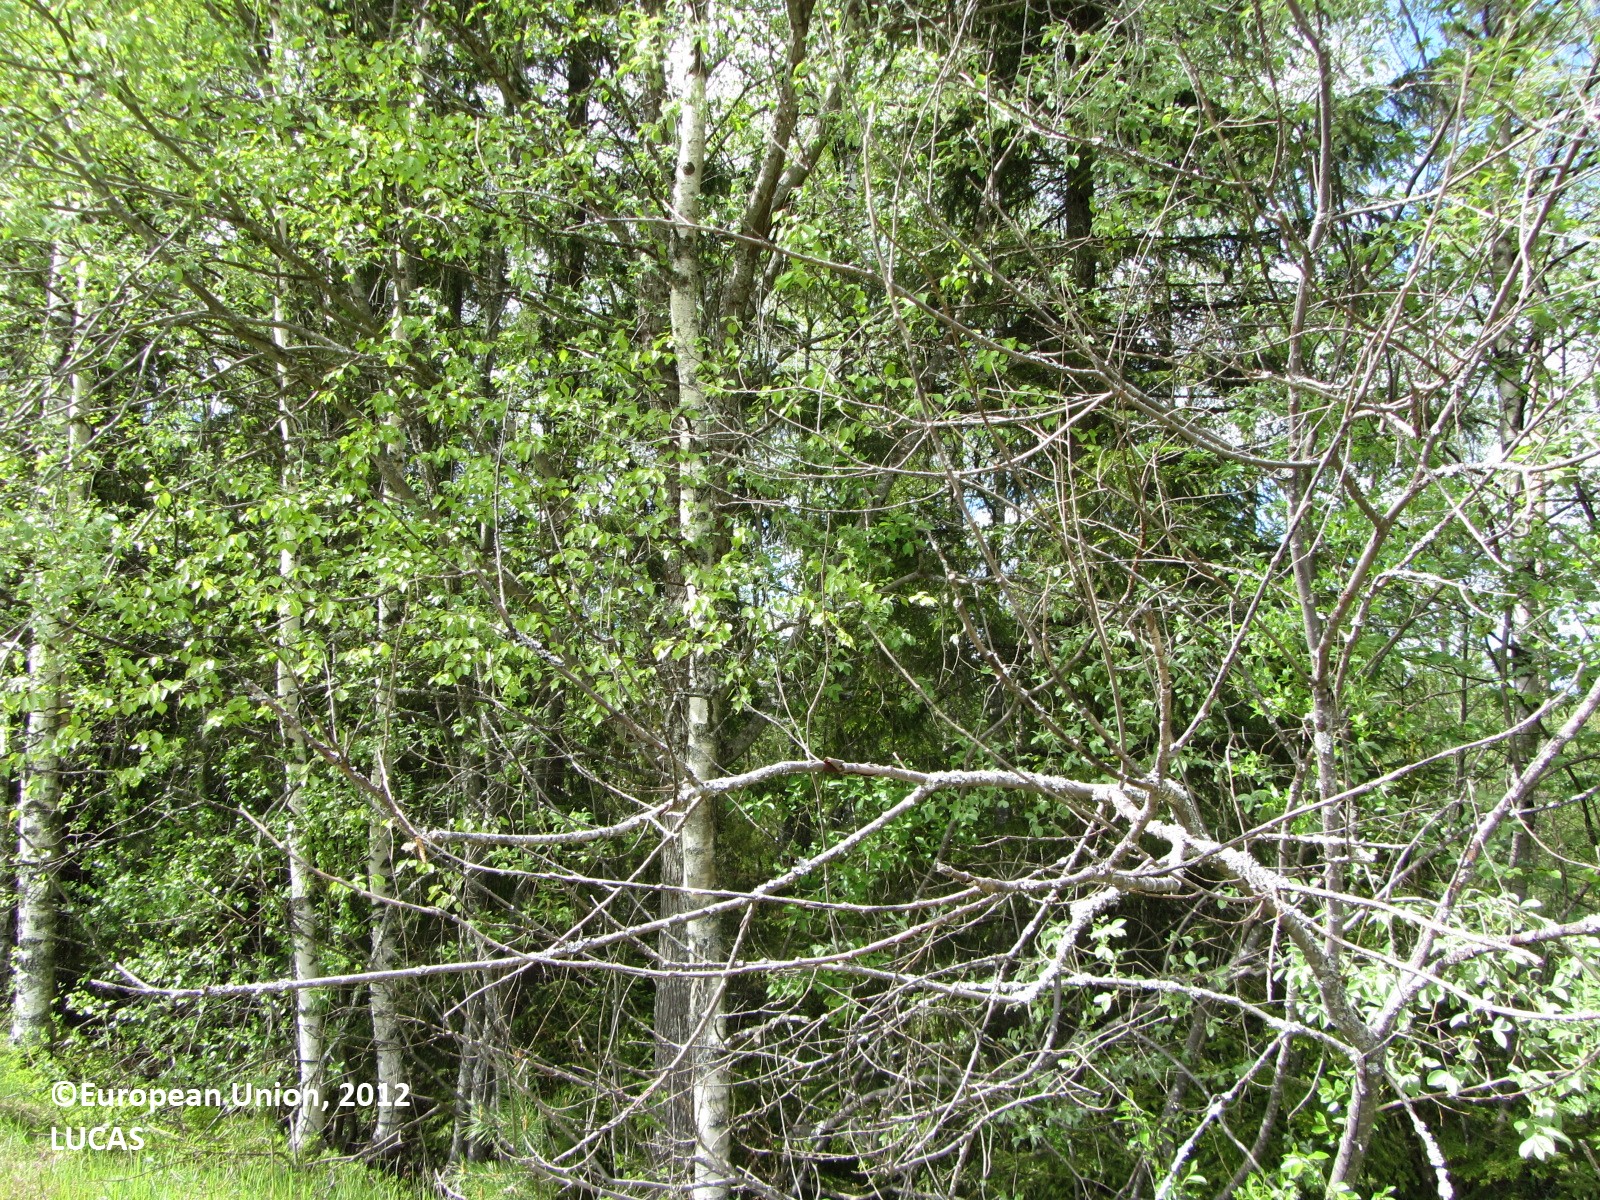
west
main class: Cropland
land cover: Temporary grasslands
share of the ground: > 75 %
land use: Agriculture (excluding fallow land and kitchen gardens)
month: May
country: FI
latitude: 62.4890
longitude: 25.4606
